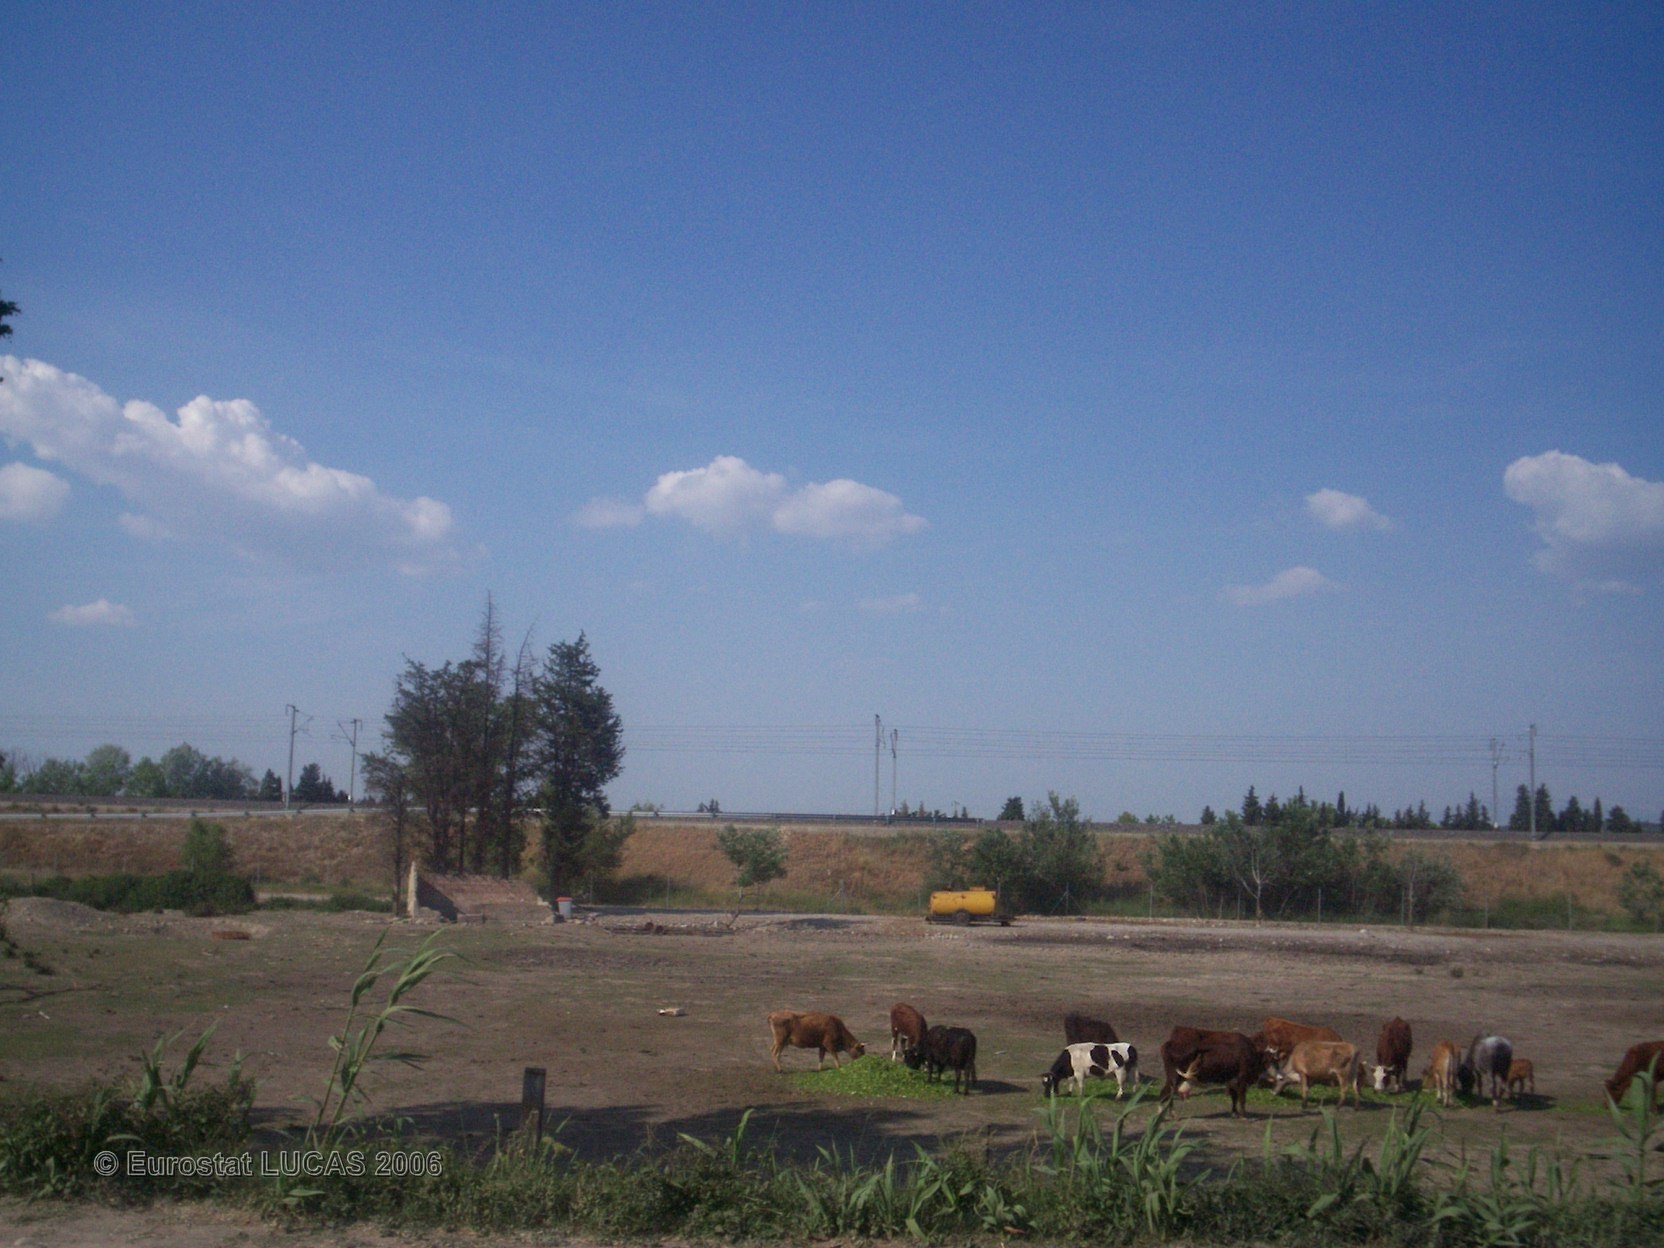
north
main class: Grassland
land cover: Grassland without tree/shrub cover
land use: Agriculture (excluding fallow land and kitchen gardens)
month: May
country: FR
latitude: 43.8995
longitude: 4.8918
